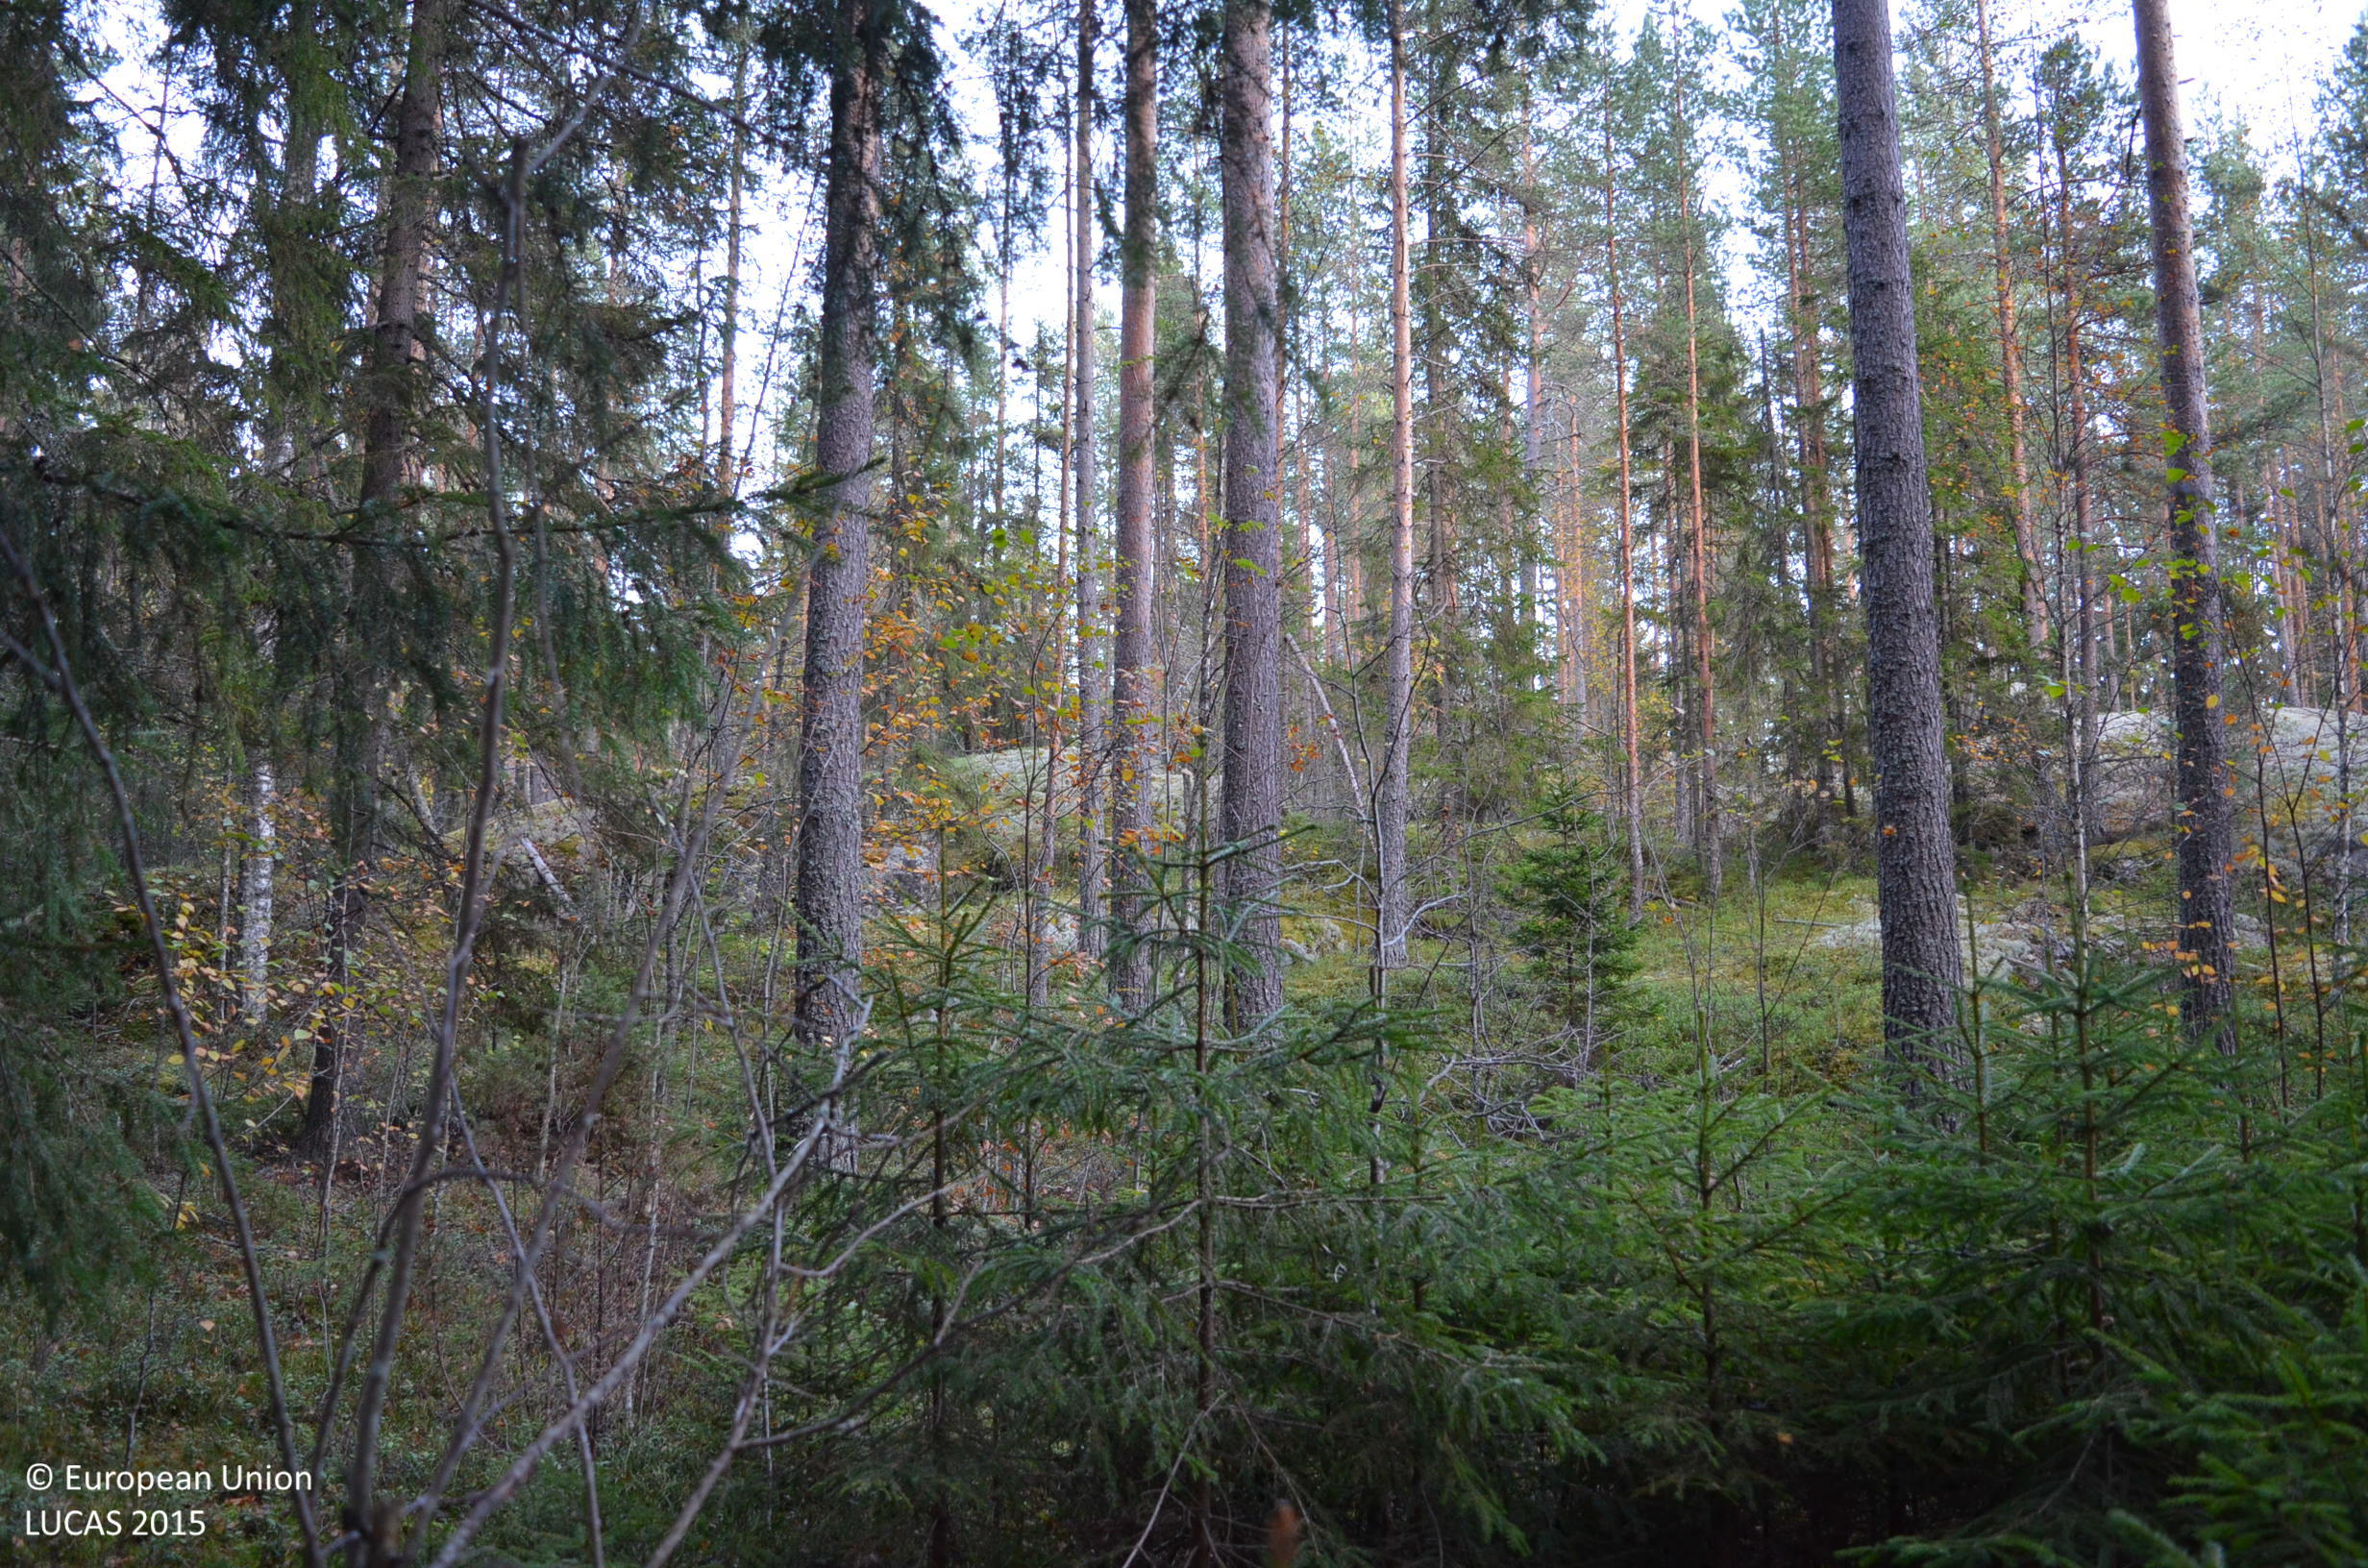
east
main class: Woodland
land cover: Spruce dominated coniferous woodland
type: boreal forest
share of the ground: > 75 %
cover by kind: coniferous forest trees 60 %, shrubs 20 %, broadleaved forest trees 15 %, lichens and mosses 5 %
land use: Forestry
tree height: > 5 m
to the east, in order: Spruce dominated coniferous woodland; Other mixed woodland; Pine dominated coniferous woodland; Other coniferous woodland; Other mixed woodland
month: October
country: FI
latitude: 61.7442
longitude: 23.8882
